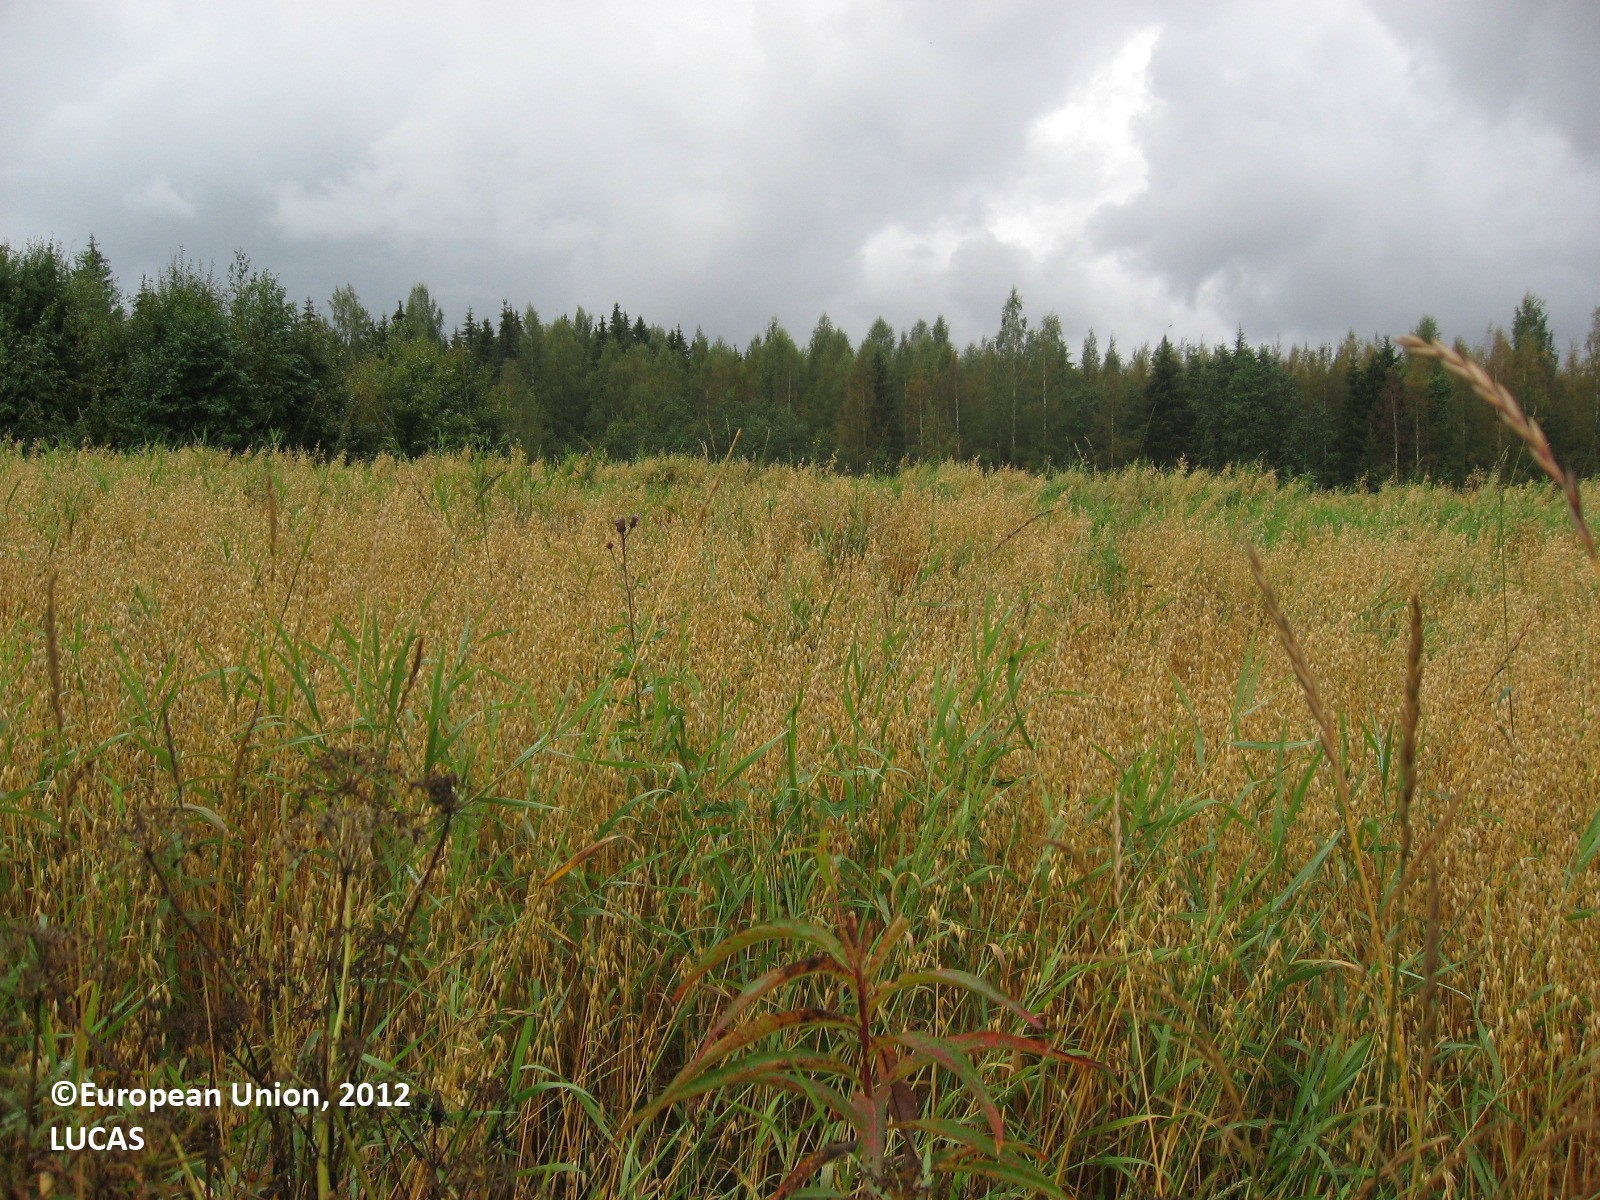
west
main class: Cropland
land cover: Oats
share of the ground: > 75 %
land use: Agriculture (excluding fallow land and kitchen gardens)
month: September
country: FI
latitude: 60.9206
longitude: 25.3013
